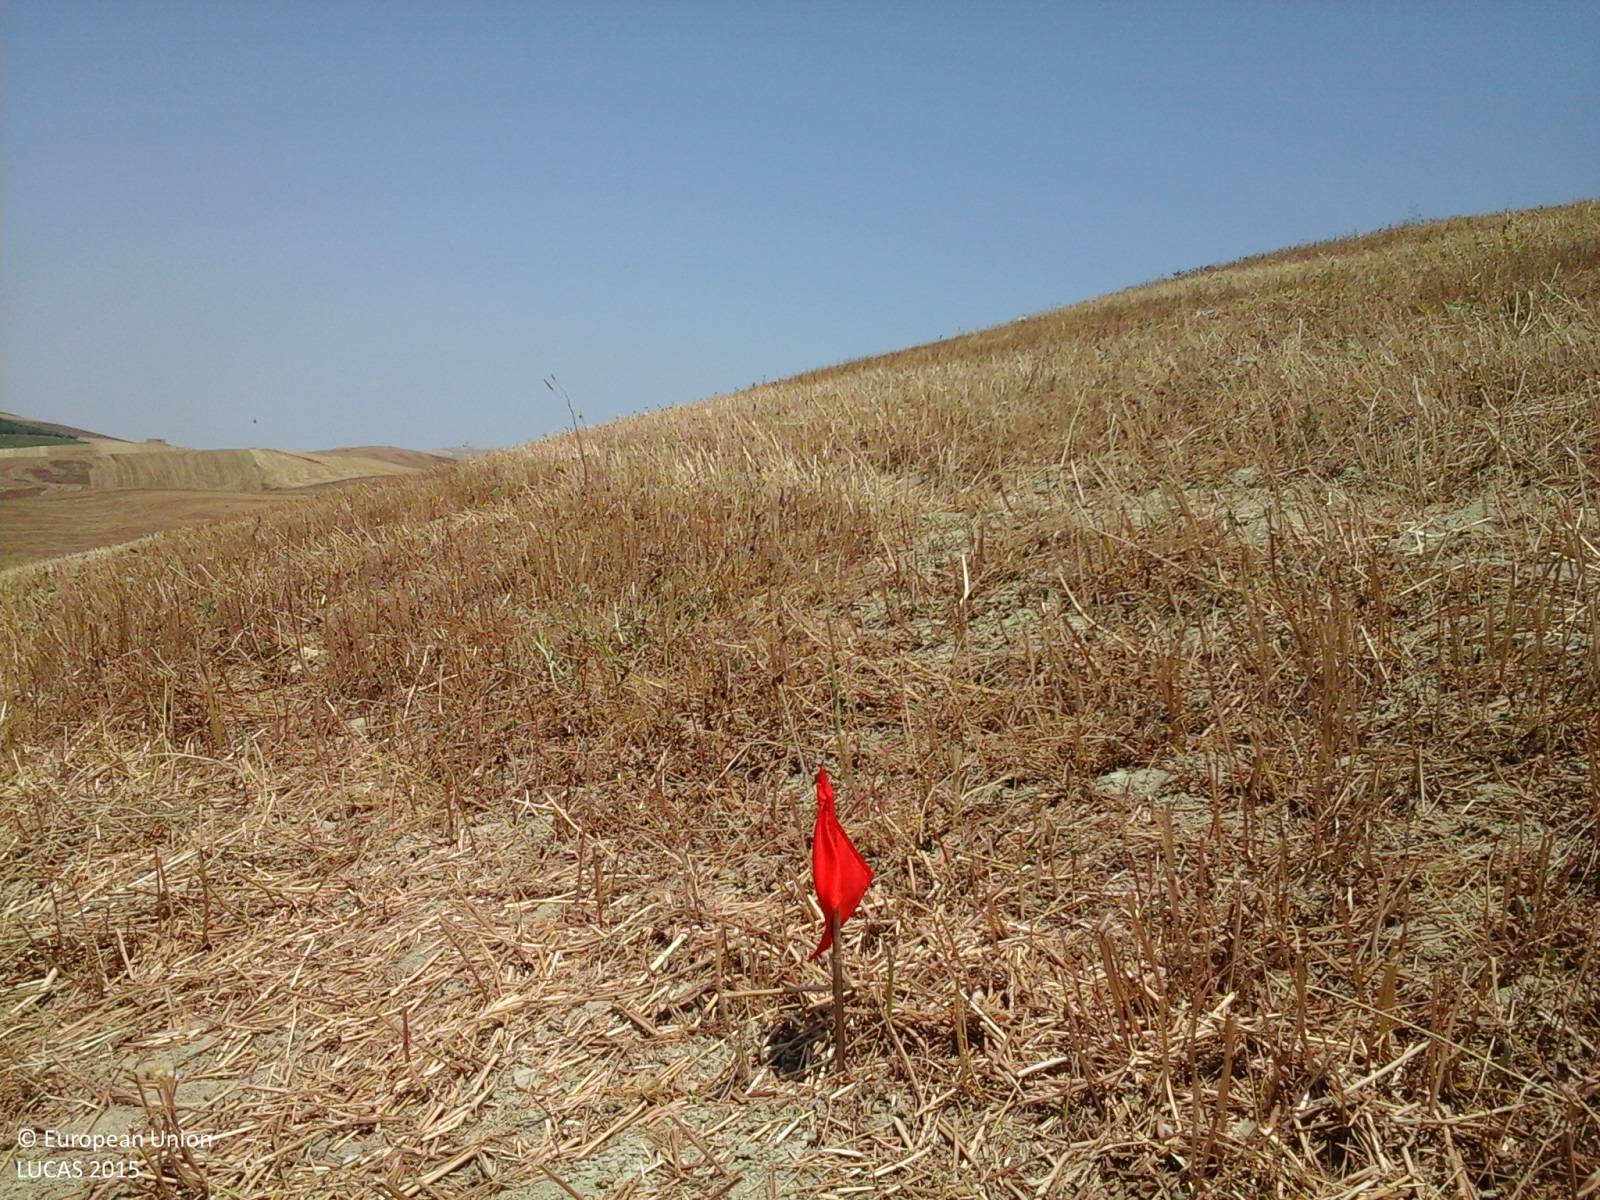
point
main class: Cropland
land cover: Other leguminous and mixtures for fodder
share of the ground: > 75 %
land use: Agriculture (excluding fallow land and kitchen gardens)
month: July
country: IT
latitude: 37.8053
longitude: 13.1232
